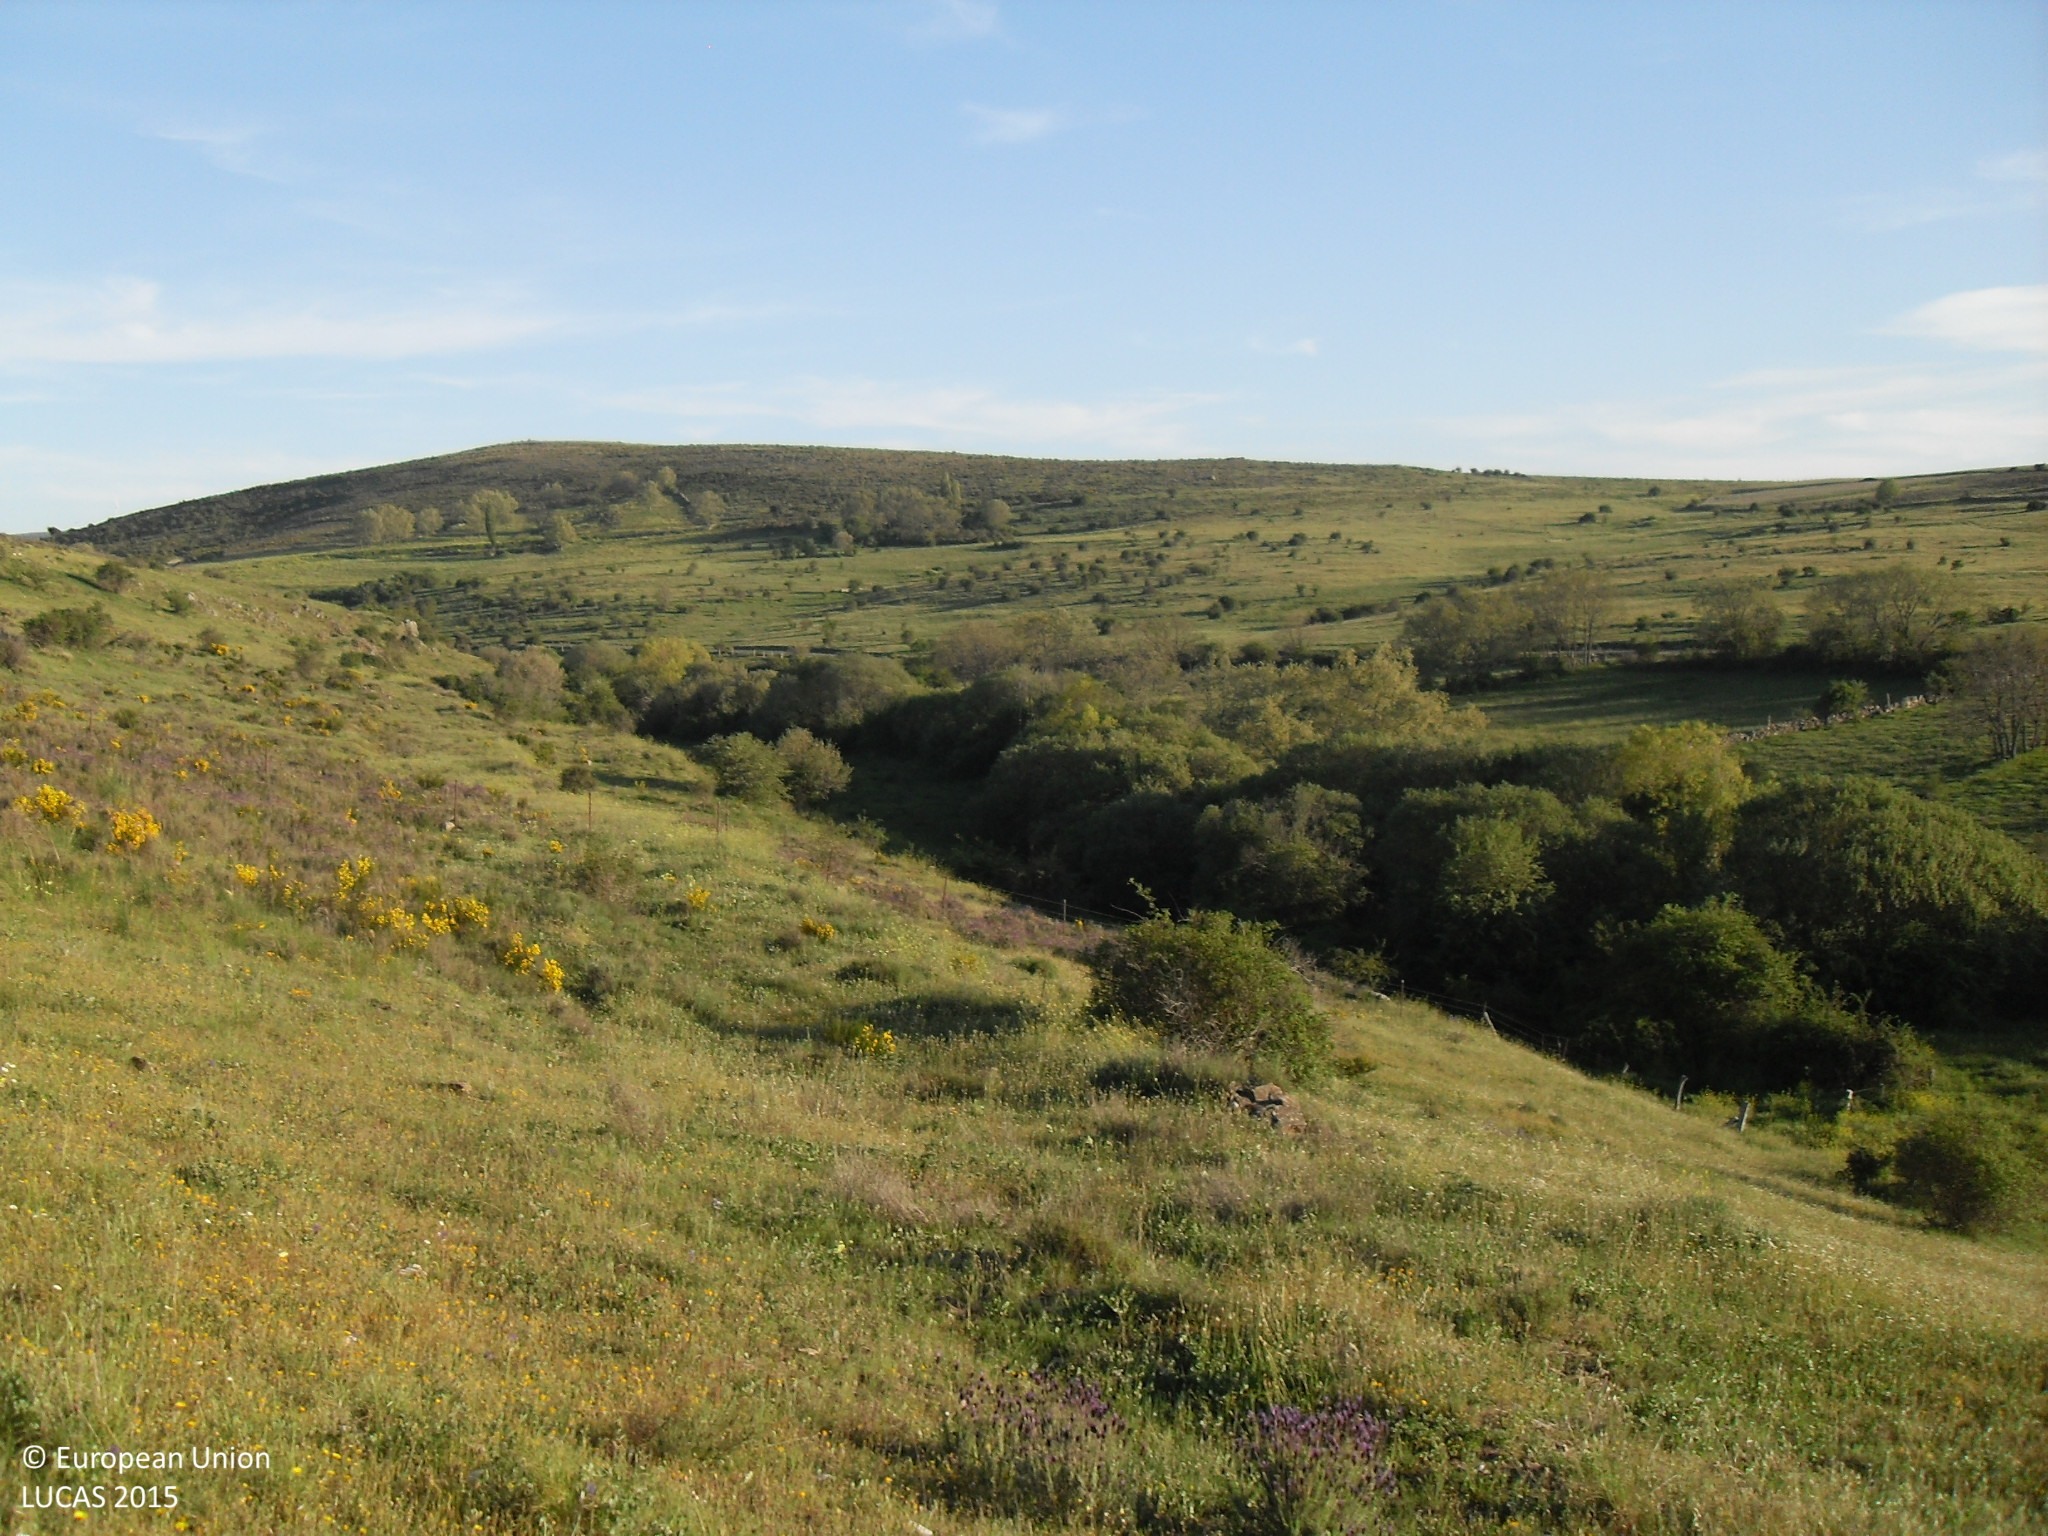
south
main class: Grassland
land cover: Grassland with sparse tree/shrub cover
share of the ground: > 75 %
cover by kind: herbaceous plants 95 %, broadleaved forest trees 5 %
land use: Agriculture (excluding fallow land and kitchen gardens)
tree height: < 5 m
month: May
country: ES
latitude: 40.6884
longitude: -5.1025
